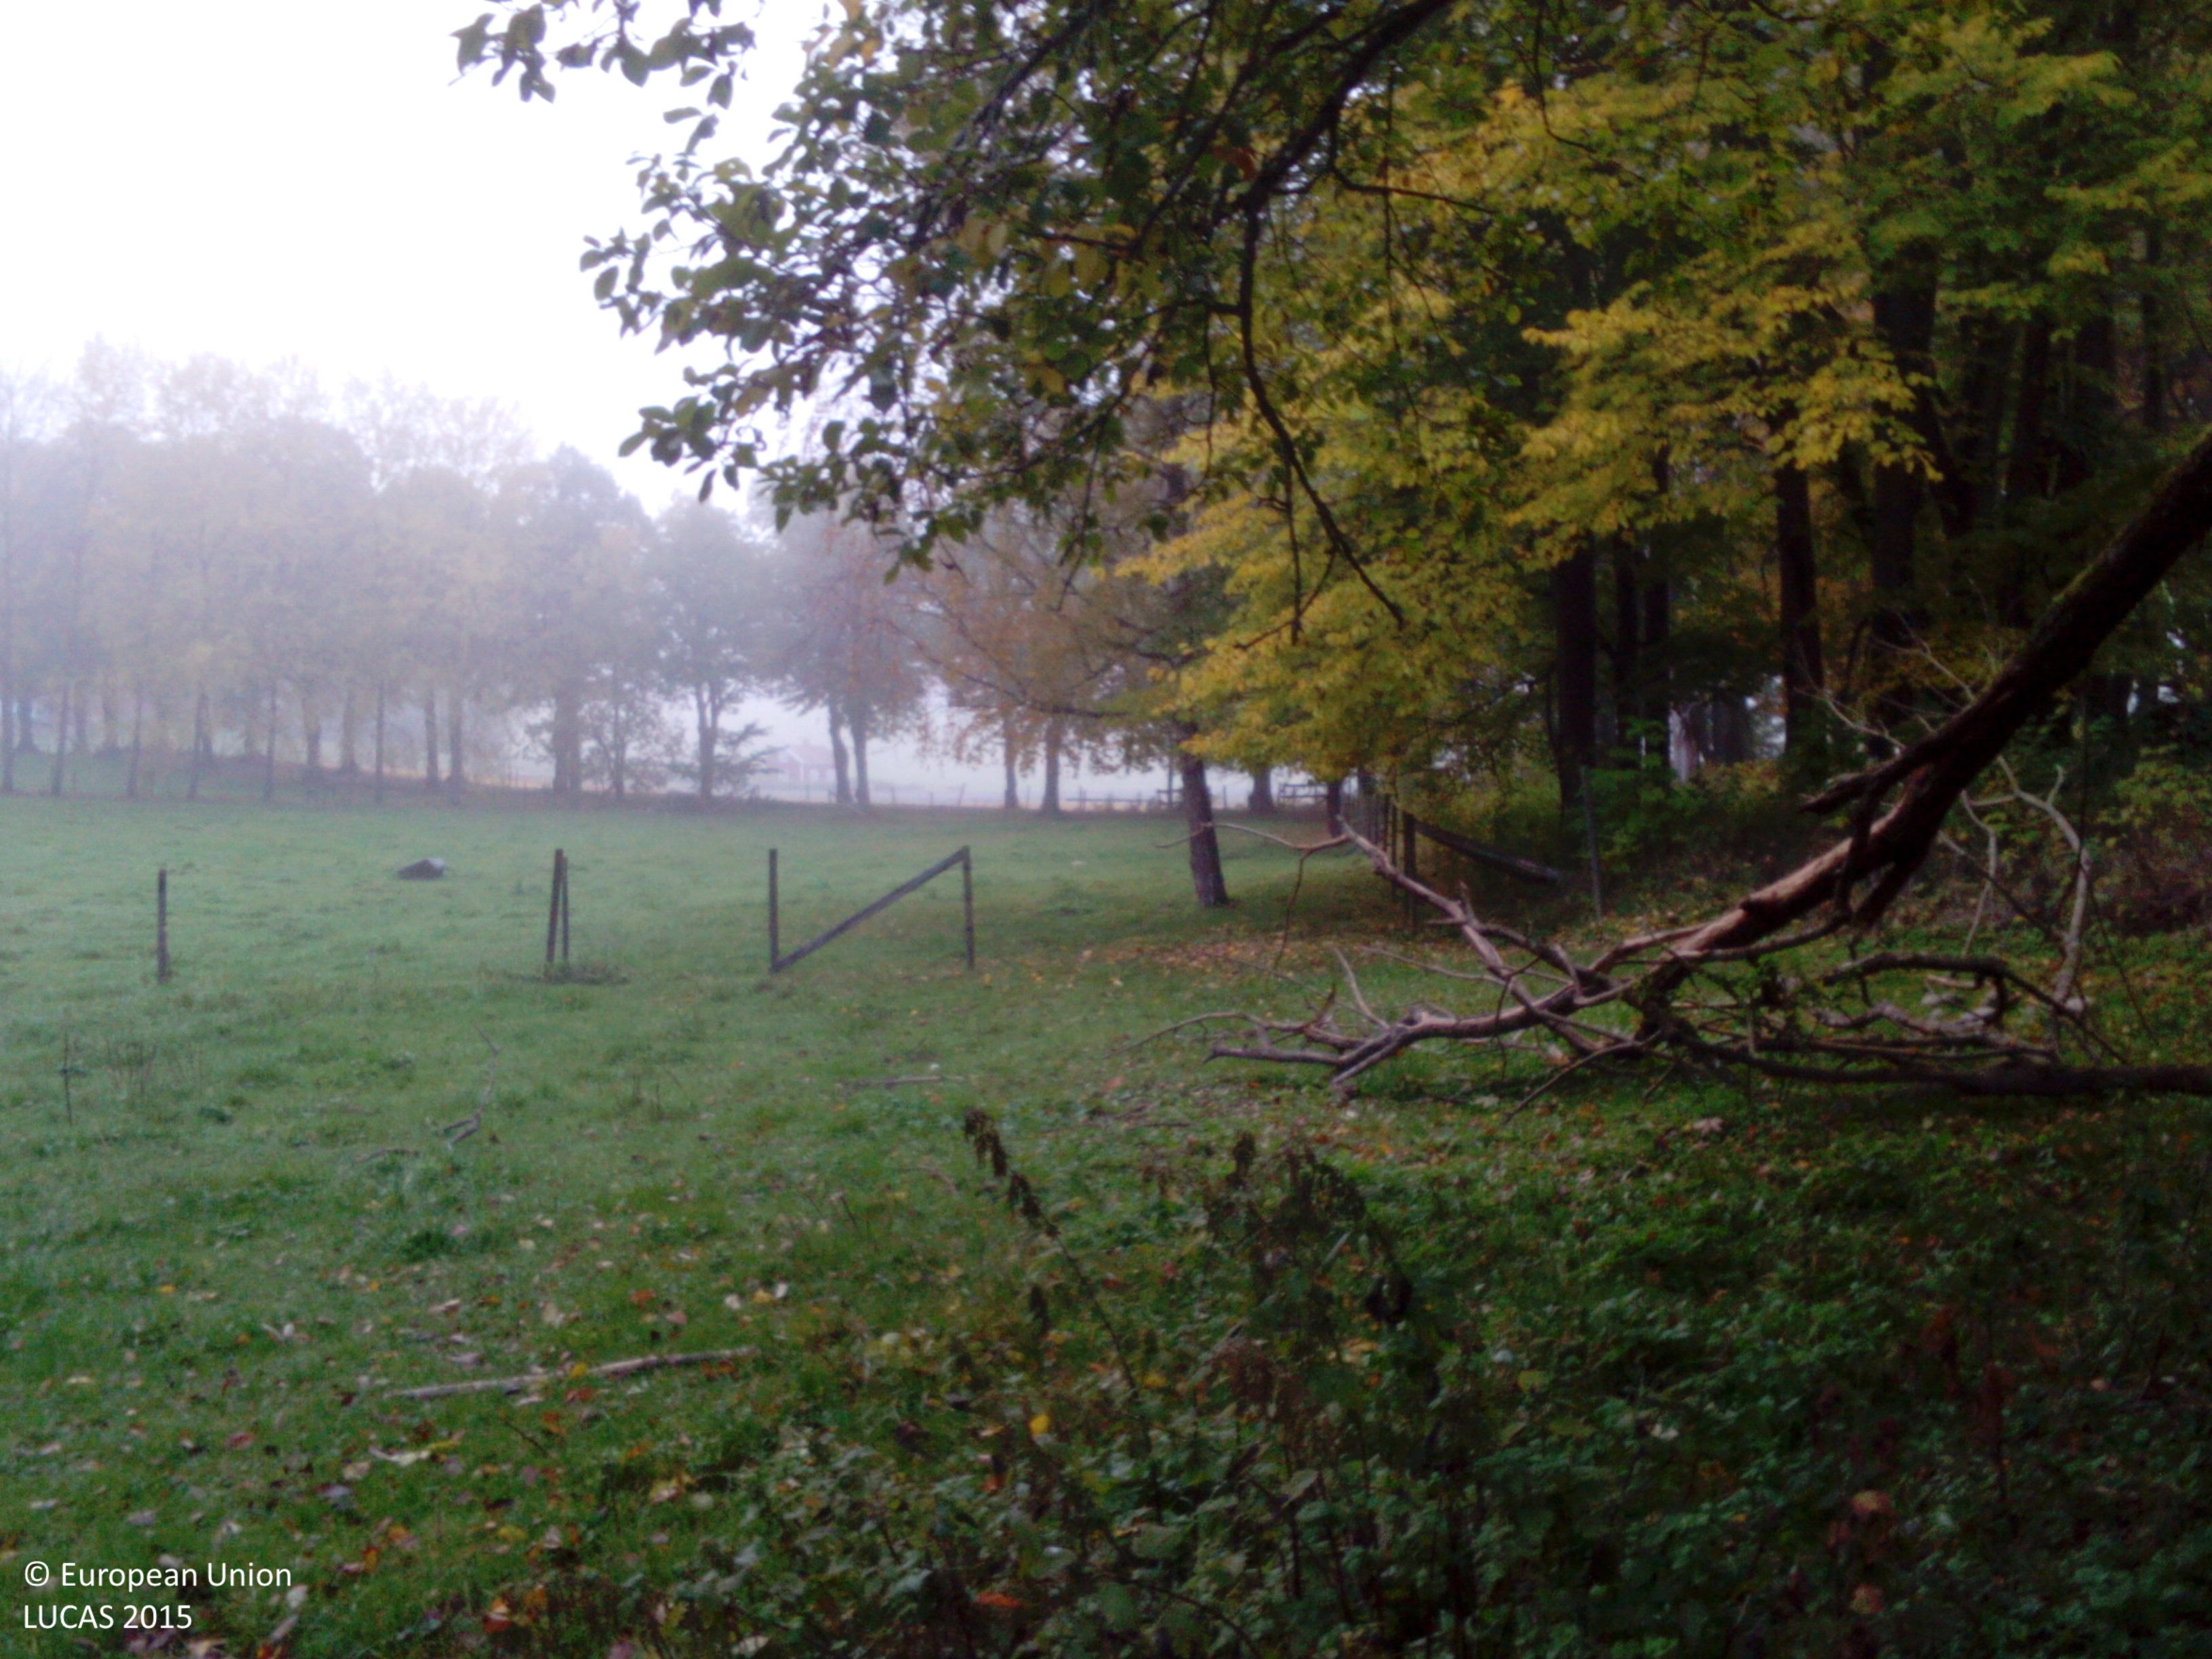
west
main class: Grassland
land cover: Grassland with sparse tree/shrub cover
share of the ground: > 75 %
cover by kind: herbaceous plants 95 %, broadleaved forest trees 5 %
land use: Agriculture (excluding fallow land and kitchen gardens)
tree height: > 5 m
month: October
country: SE
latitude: 59.0066
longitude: 16.3838
